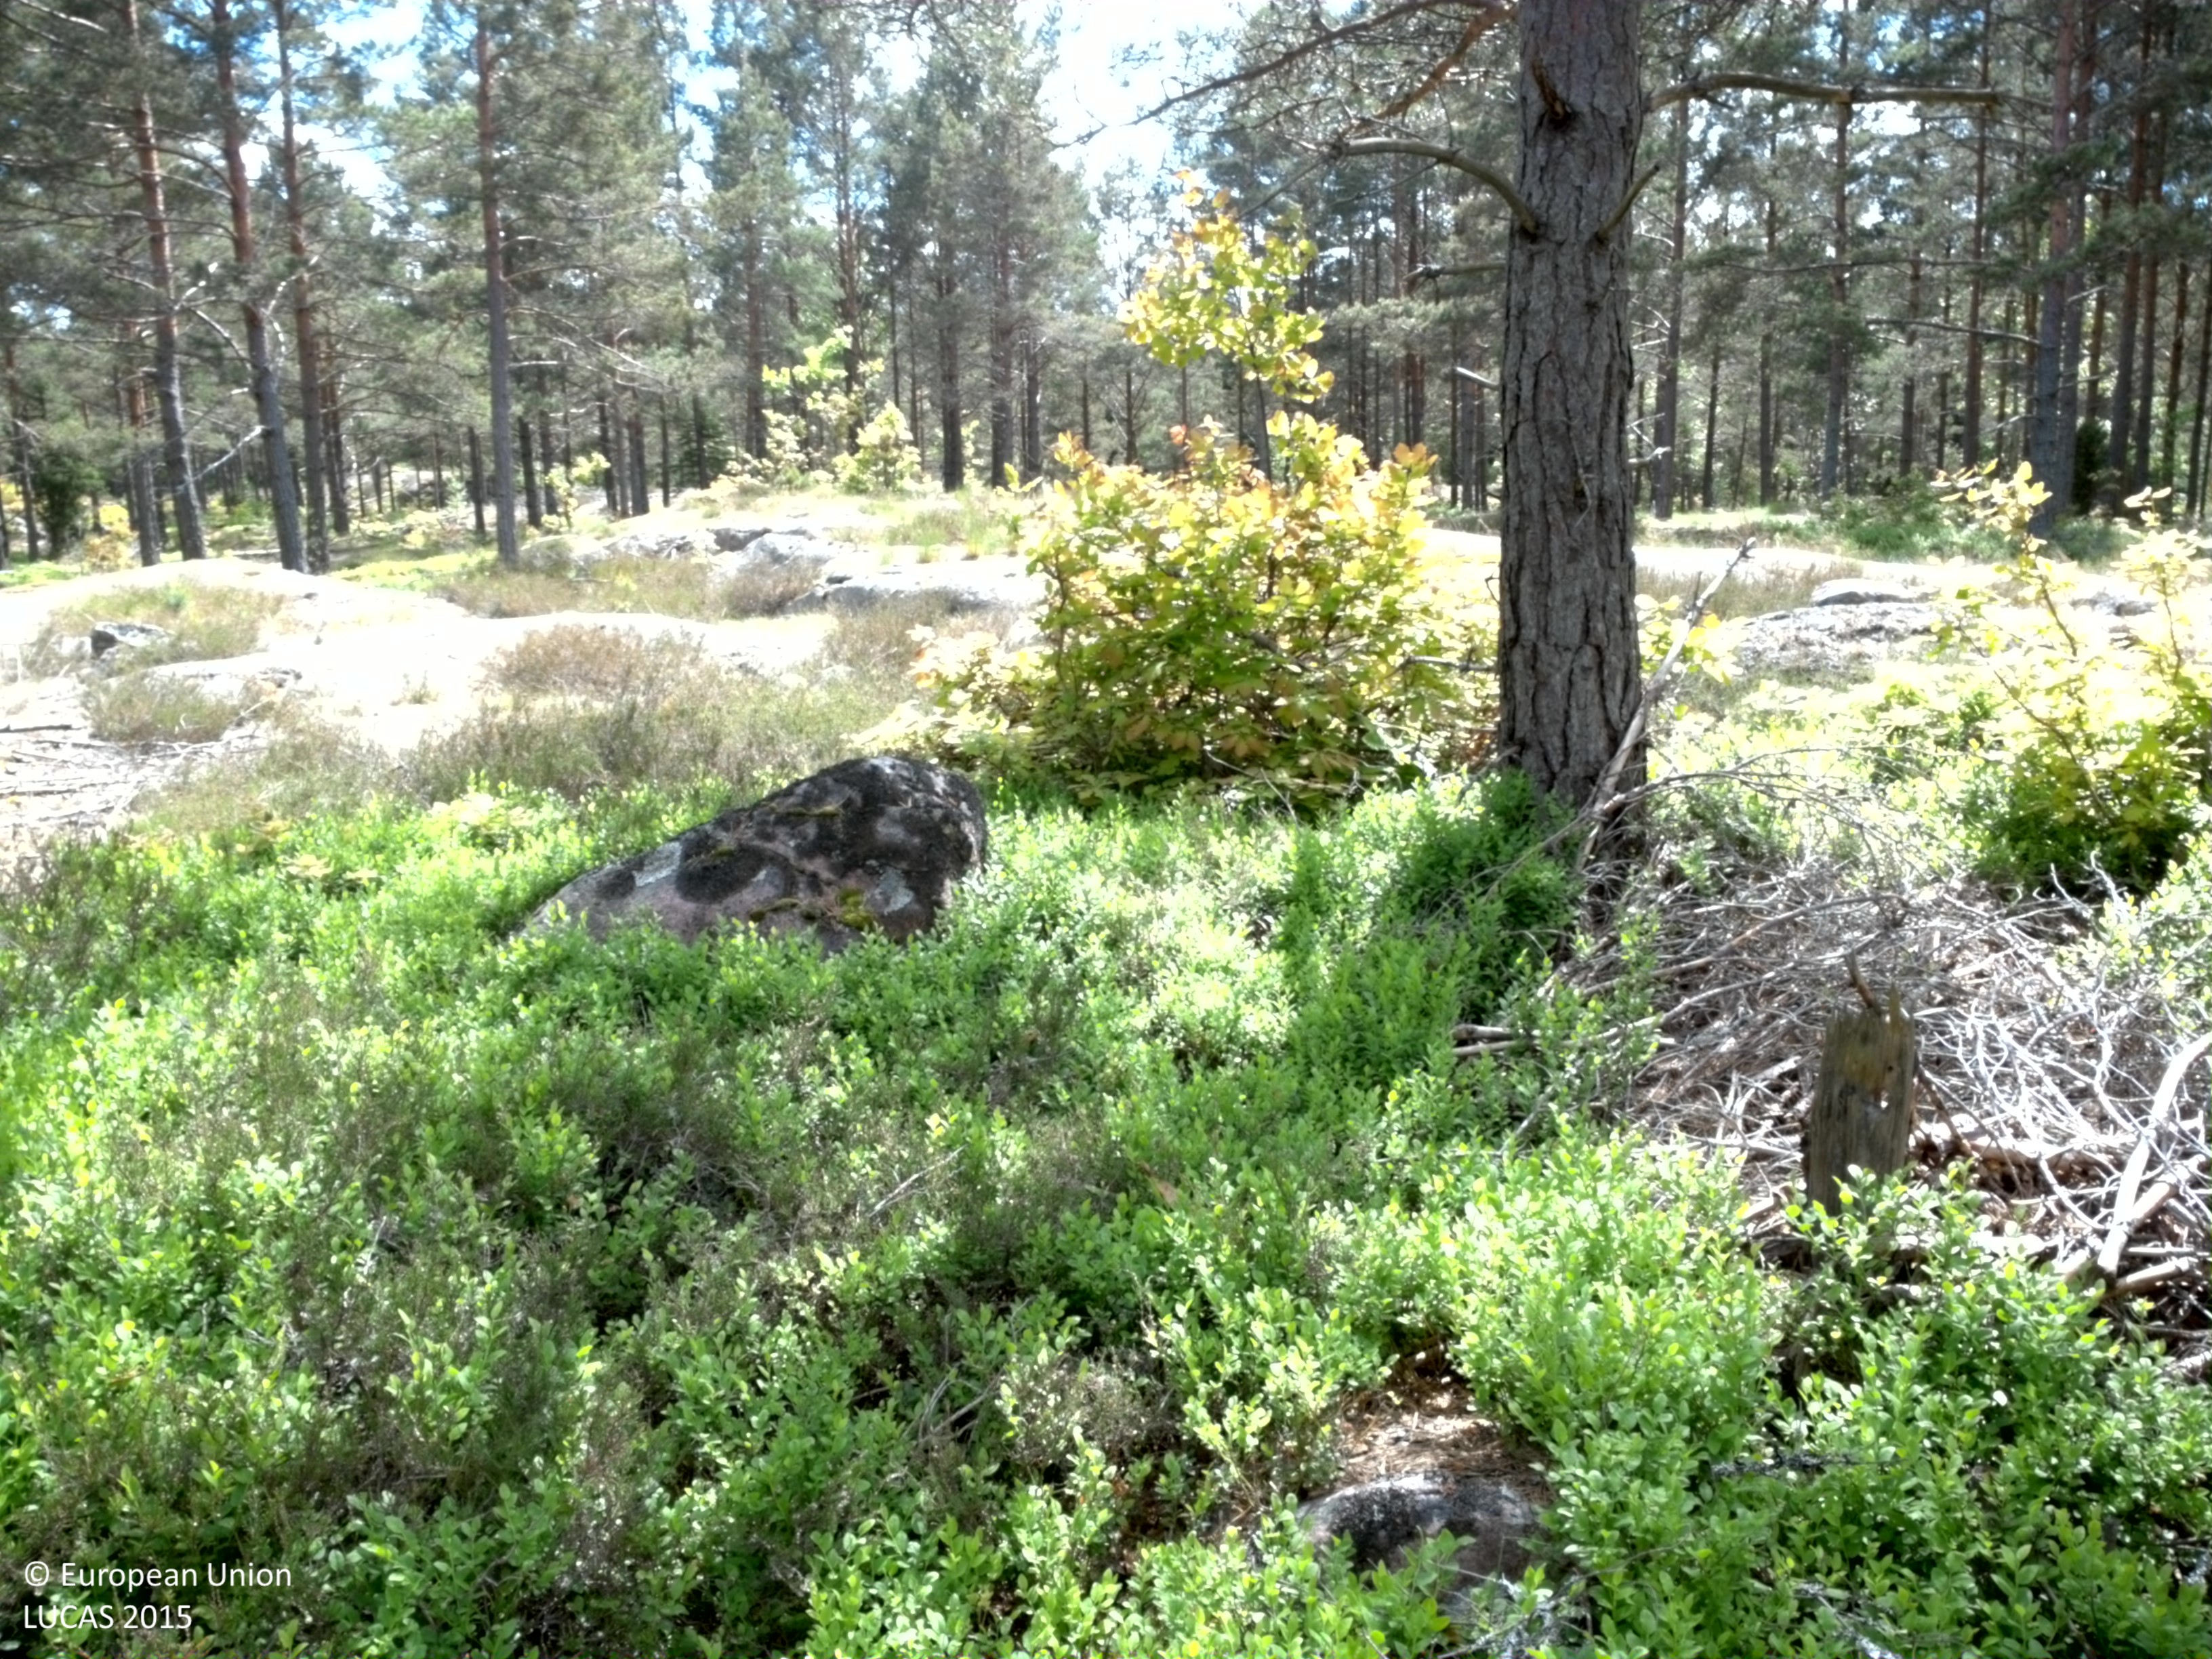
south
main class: Woodland
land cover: Pine dominated coniferous woodland
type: boreal forest
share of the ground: 50 - 75 %
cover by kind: coniferous forest trees 50 %, shrubs 25 %, lichens and mosses 25 %
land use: Forestry
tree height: > 5 m
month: May
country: SE
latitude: 57.1631
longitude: 16.4321
